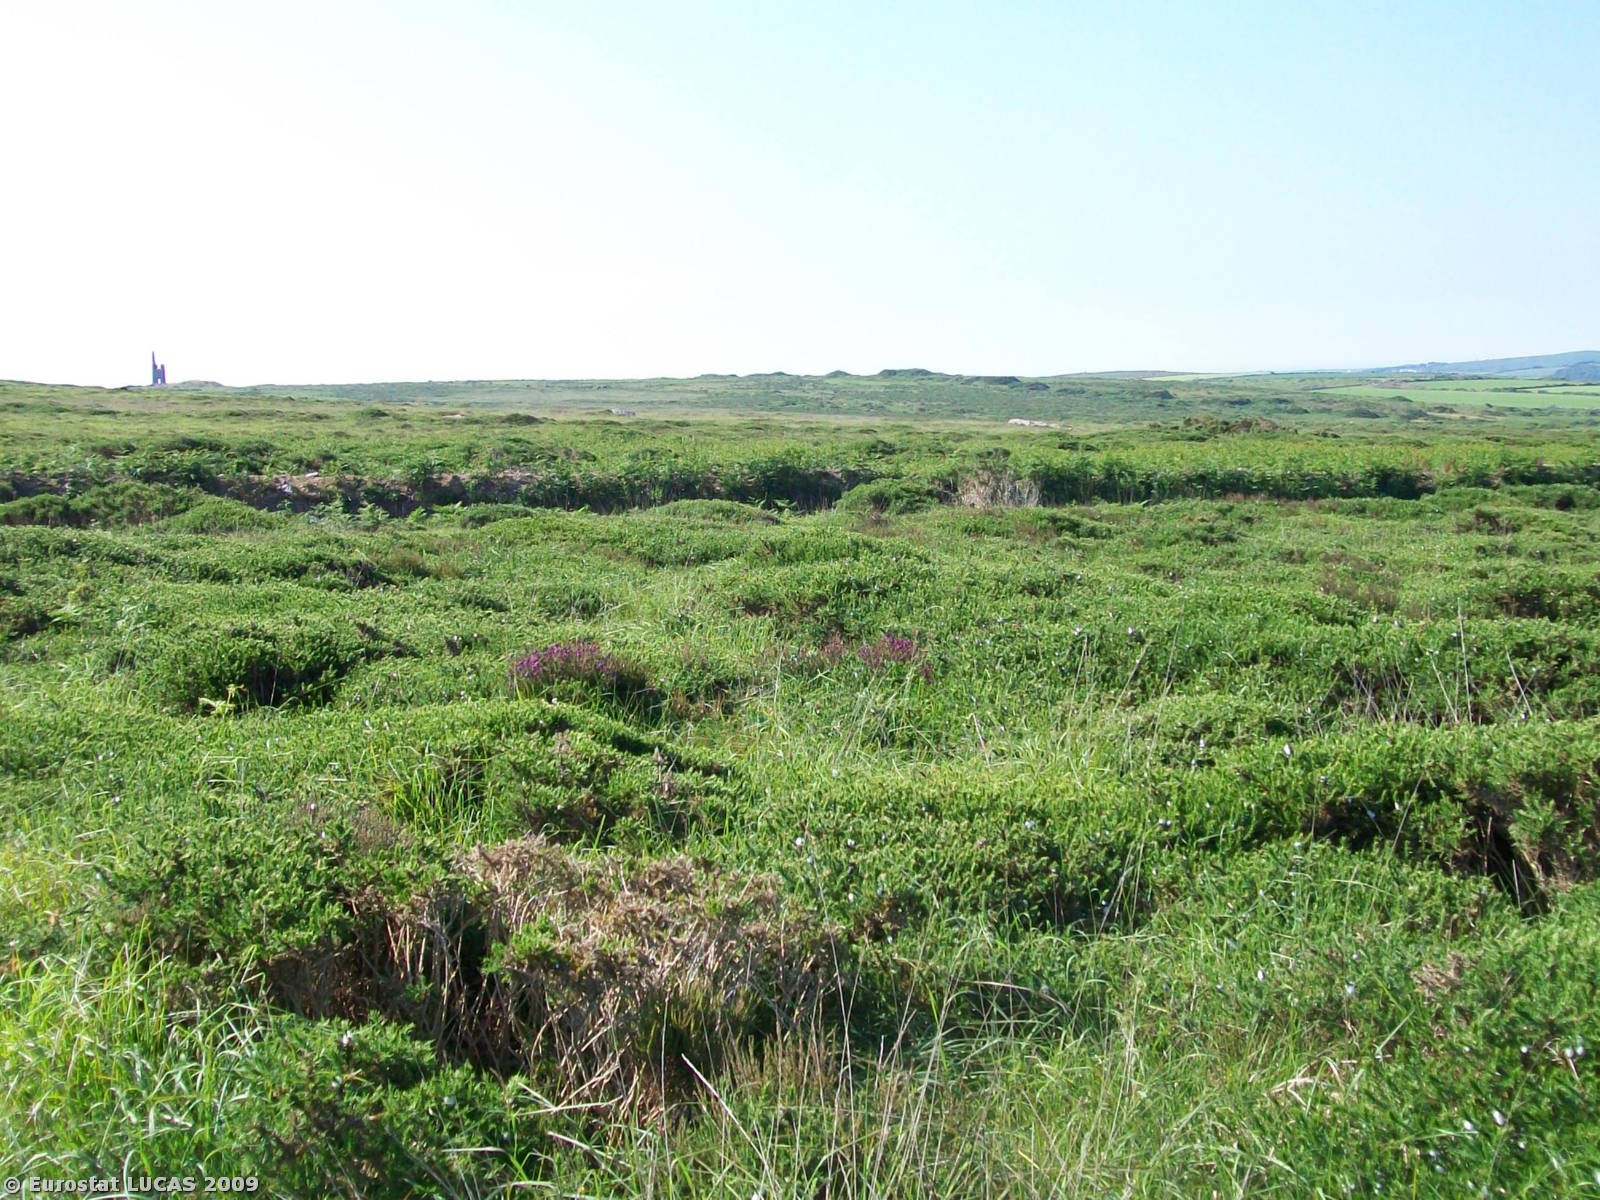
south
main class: Shrubland
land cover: Shrubland without tree cover
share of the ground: > 75 %
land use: Agriculture (excluding fallow land and kitchen gardens)
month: June
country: GB
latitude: 50.1643
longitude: -5.5991
